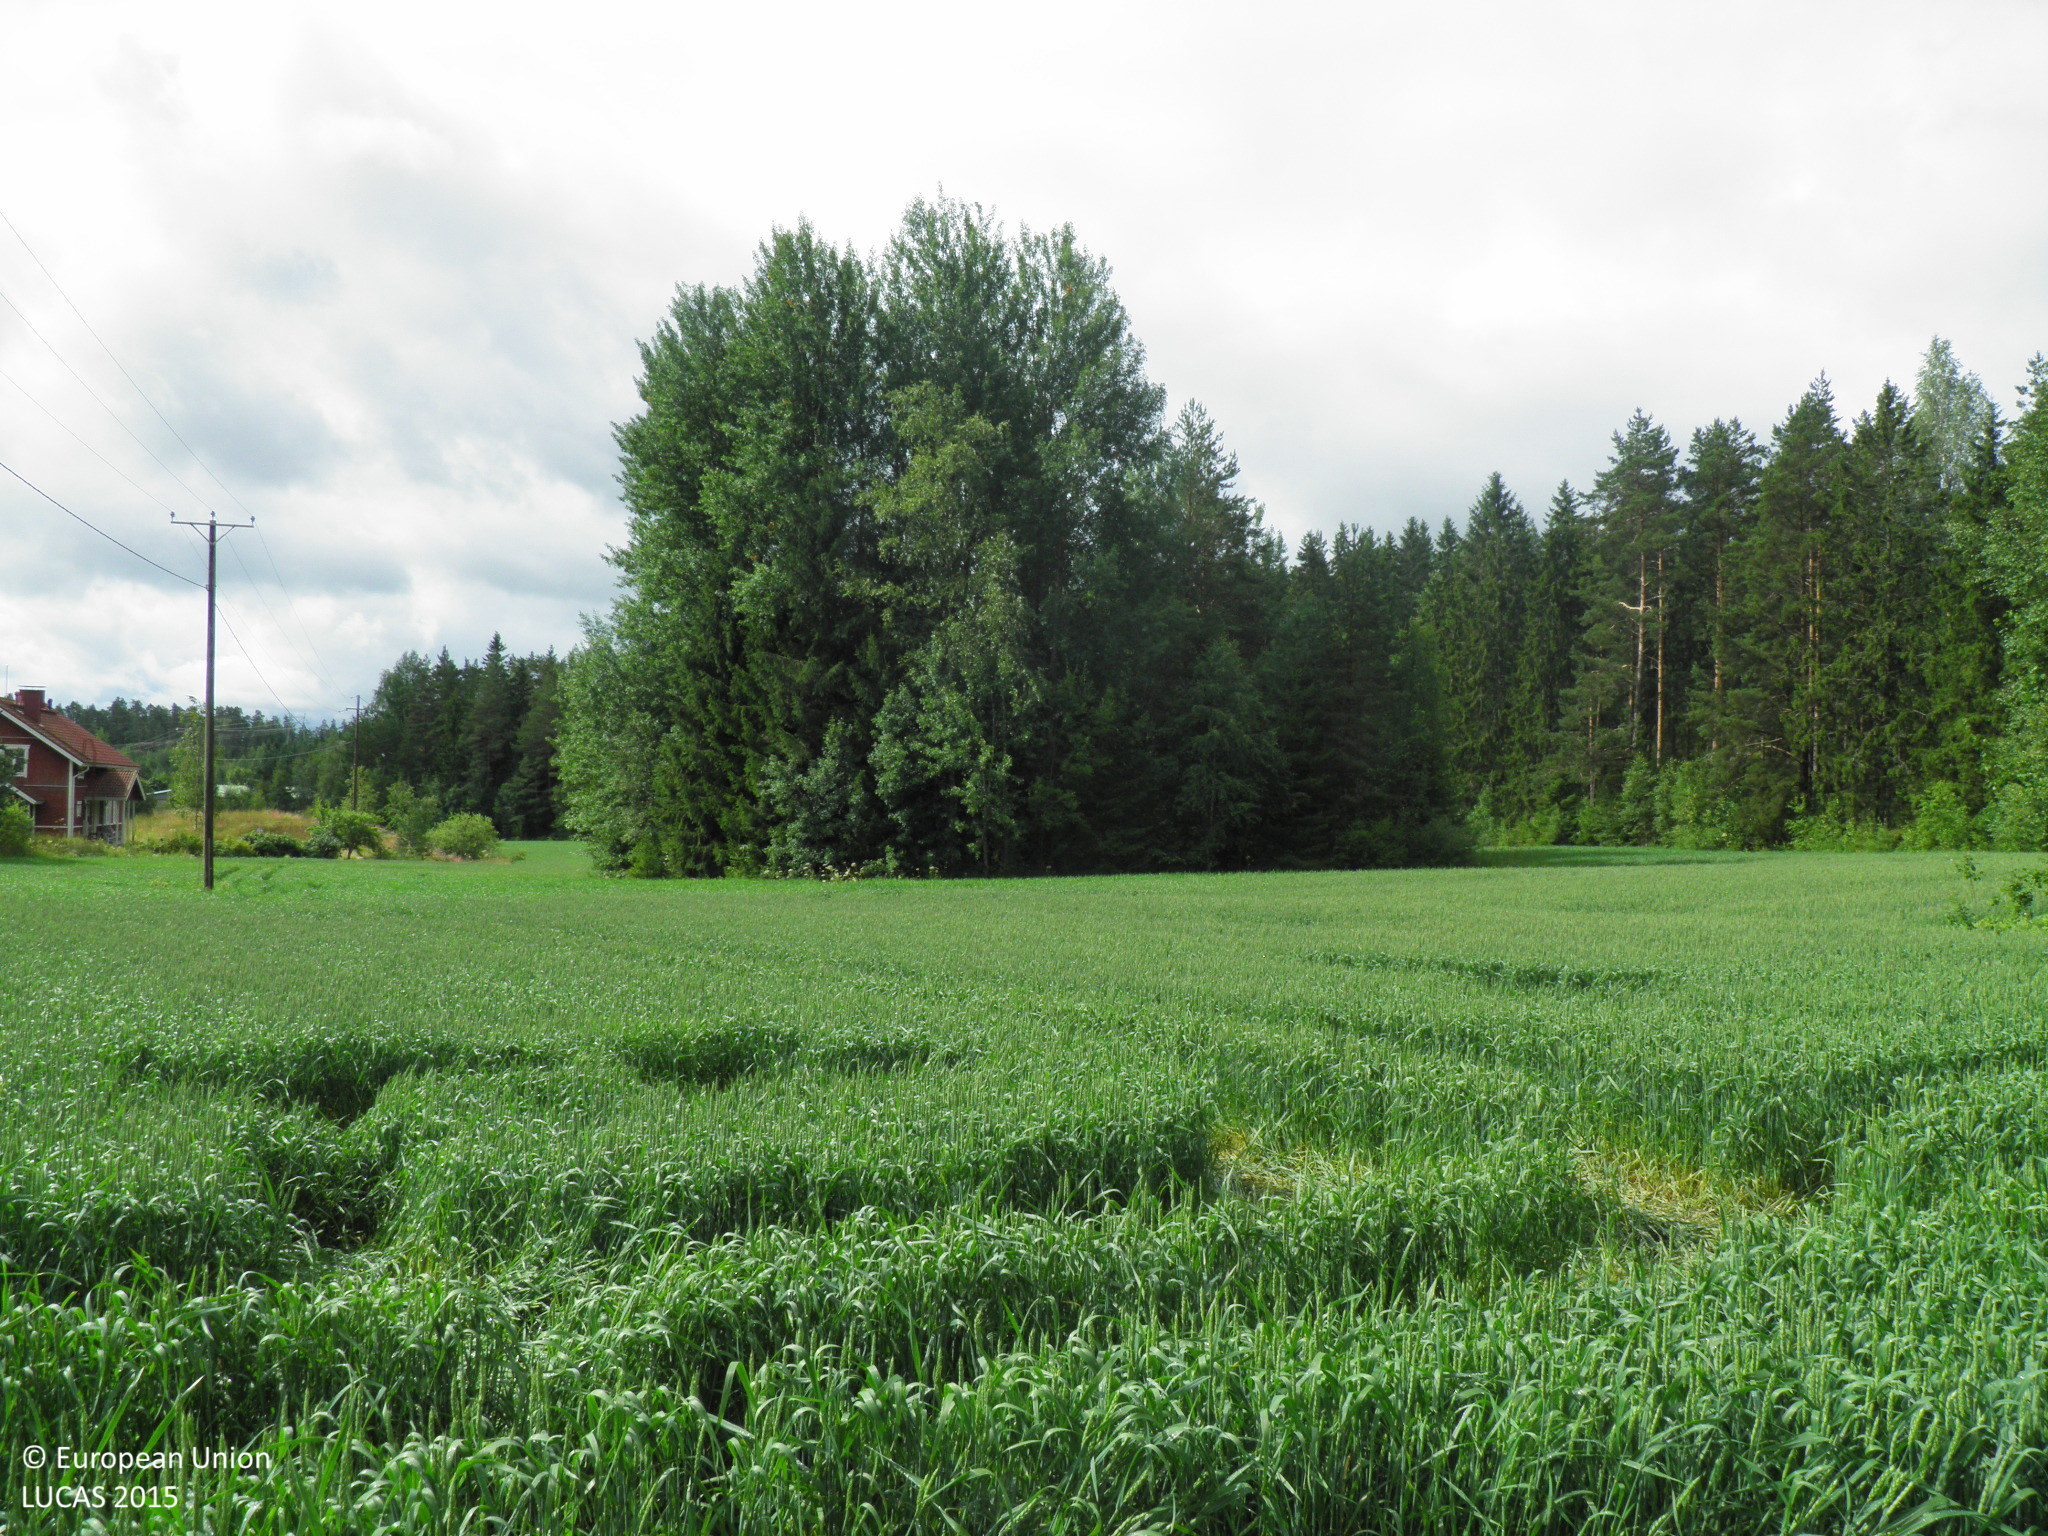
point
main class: Cropland
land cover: Common wheat
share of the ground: > 75 %
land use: Agriculture (excluding fallow land and kitchen gardens)
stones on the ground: < 10 %
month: July
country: FI
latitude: 60.1547
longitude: 22.6670
